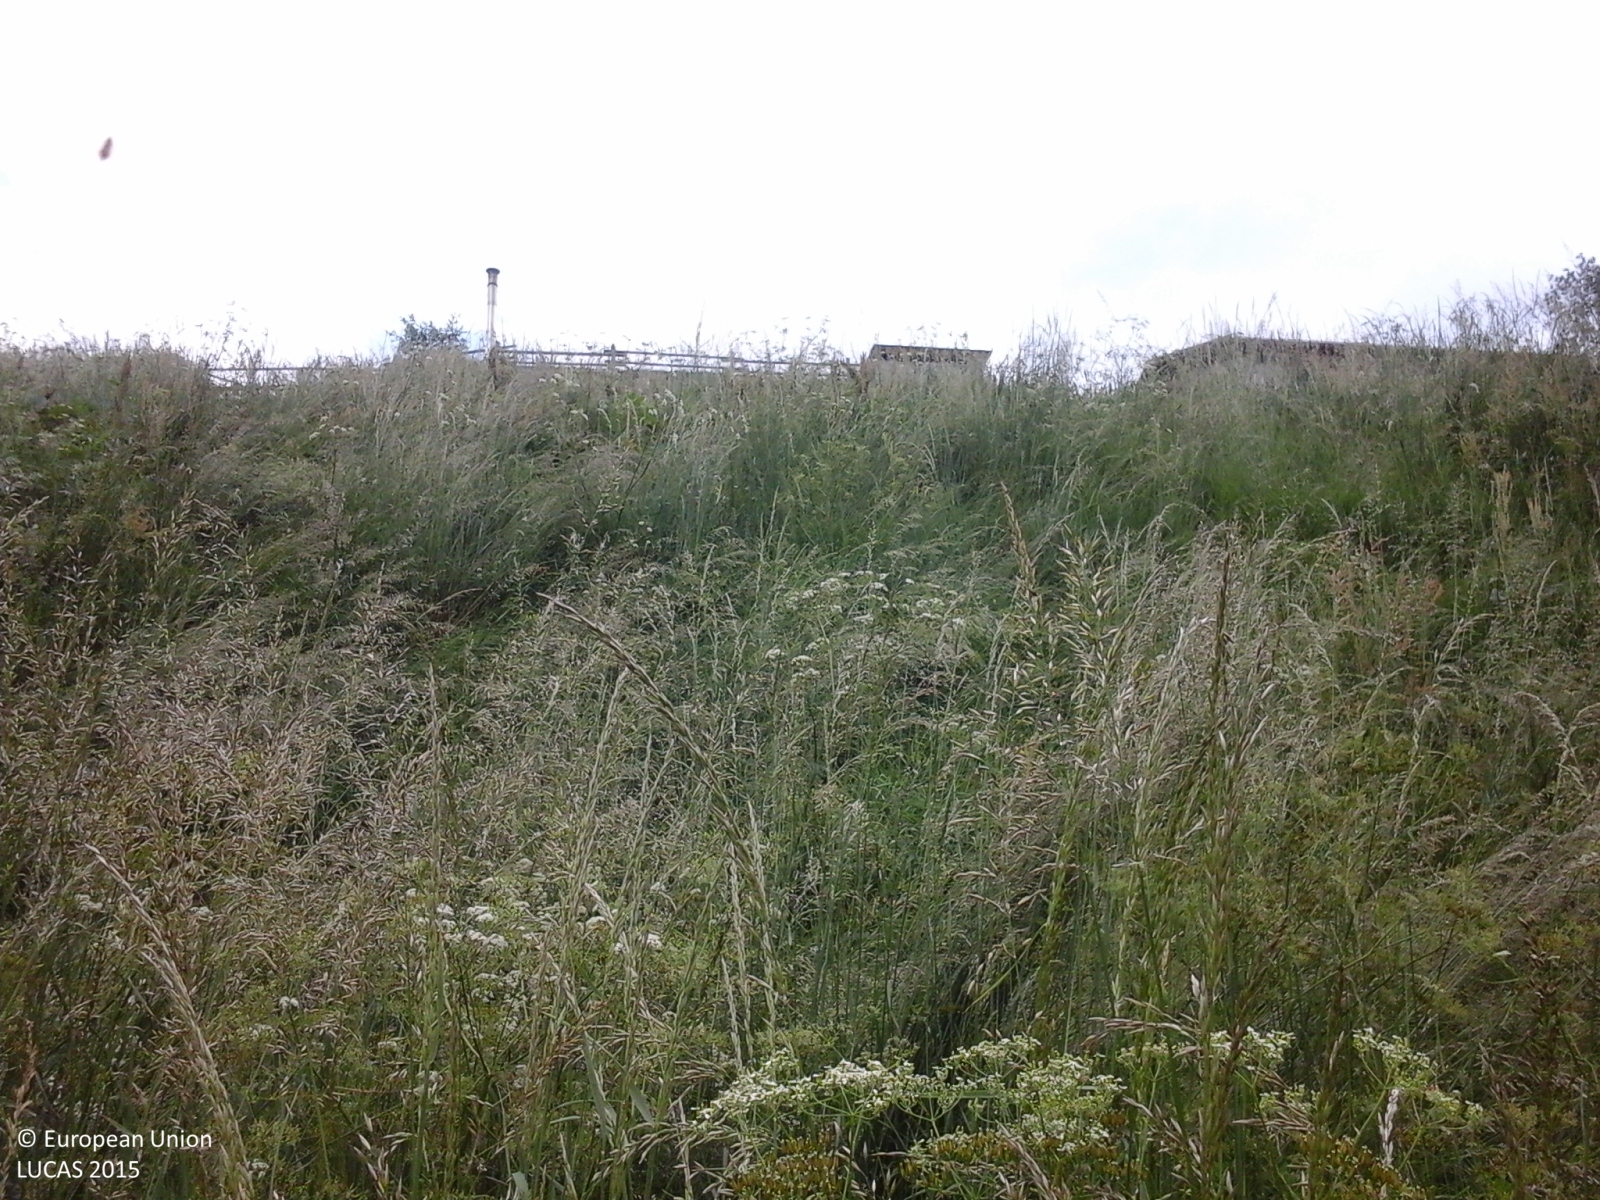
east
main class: Grassland
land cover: Grassland without tree/shrub cover
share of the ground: > 75 %
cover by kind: herbaceous plants 100 %
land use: Agriculture (excluding fallow land and kitchen gardens)
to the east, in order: Grassland without tree/shrub cover; Artificial constructions in urban areas; Grassland without tree/shrub cover; Artificial constructions in urban areas
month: June
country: IT
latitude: 46.5733
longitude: 12.5417
